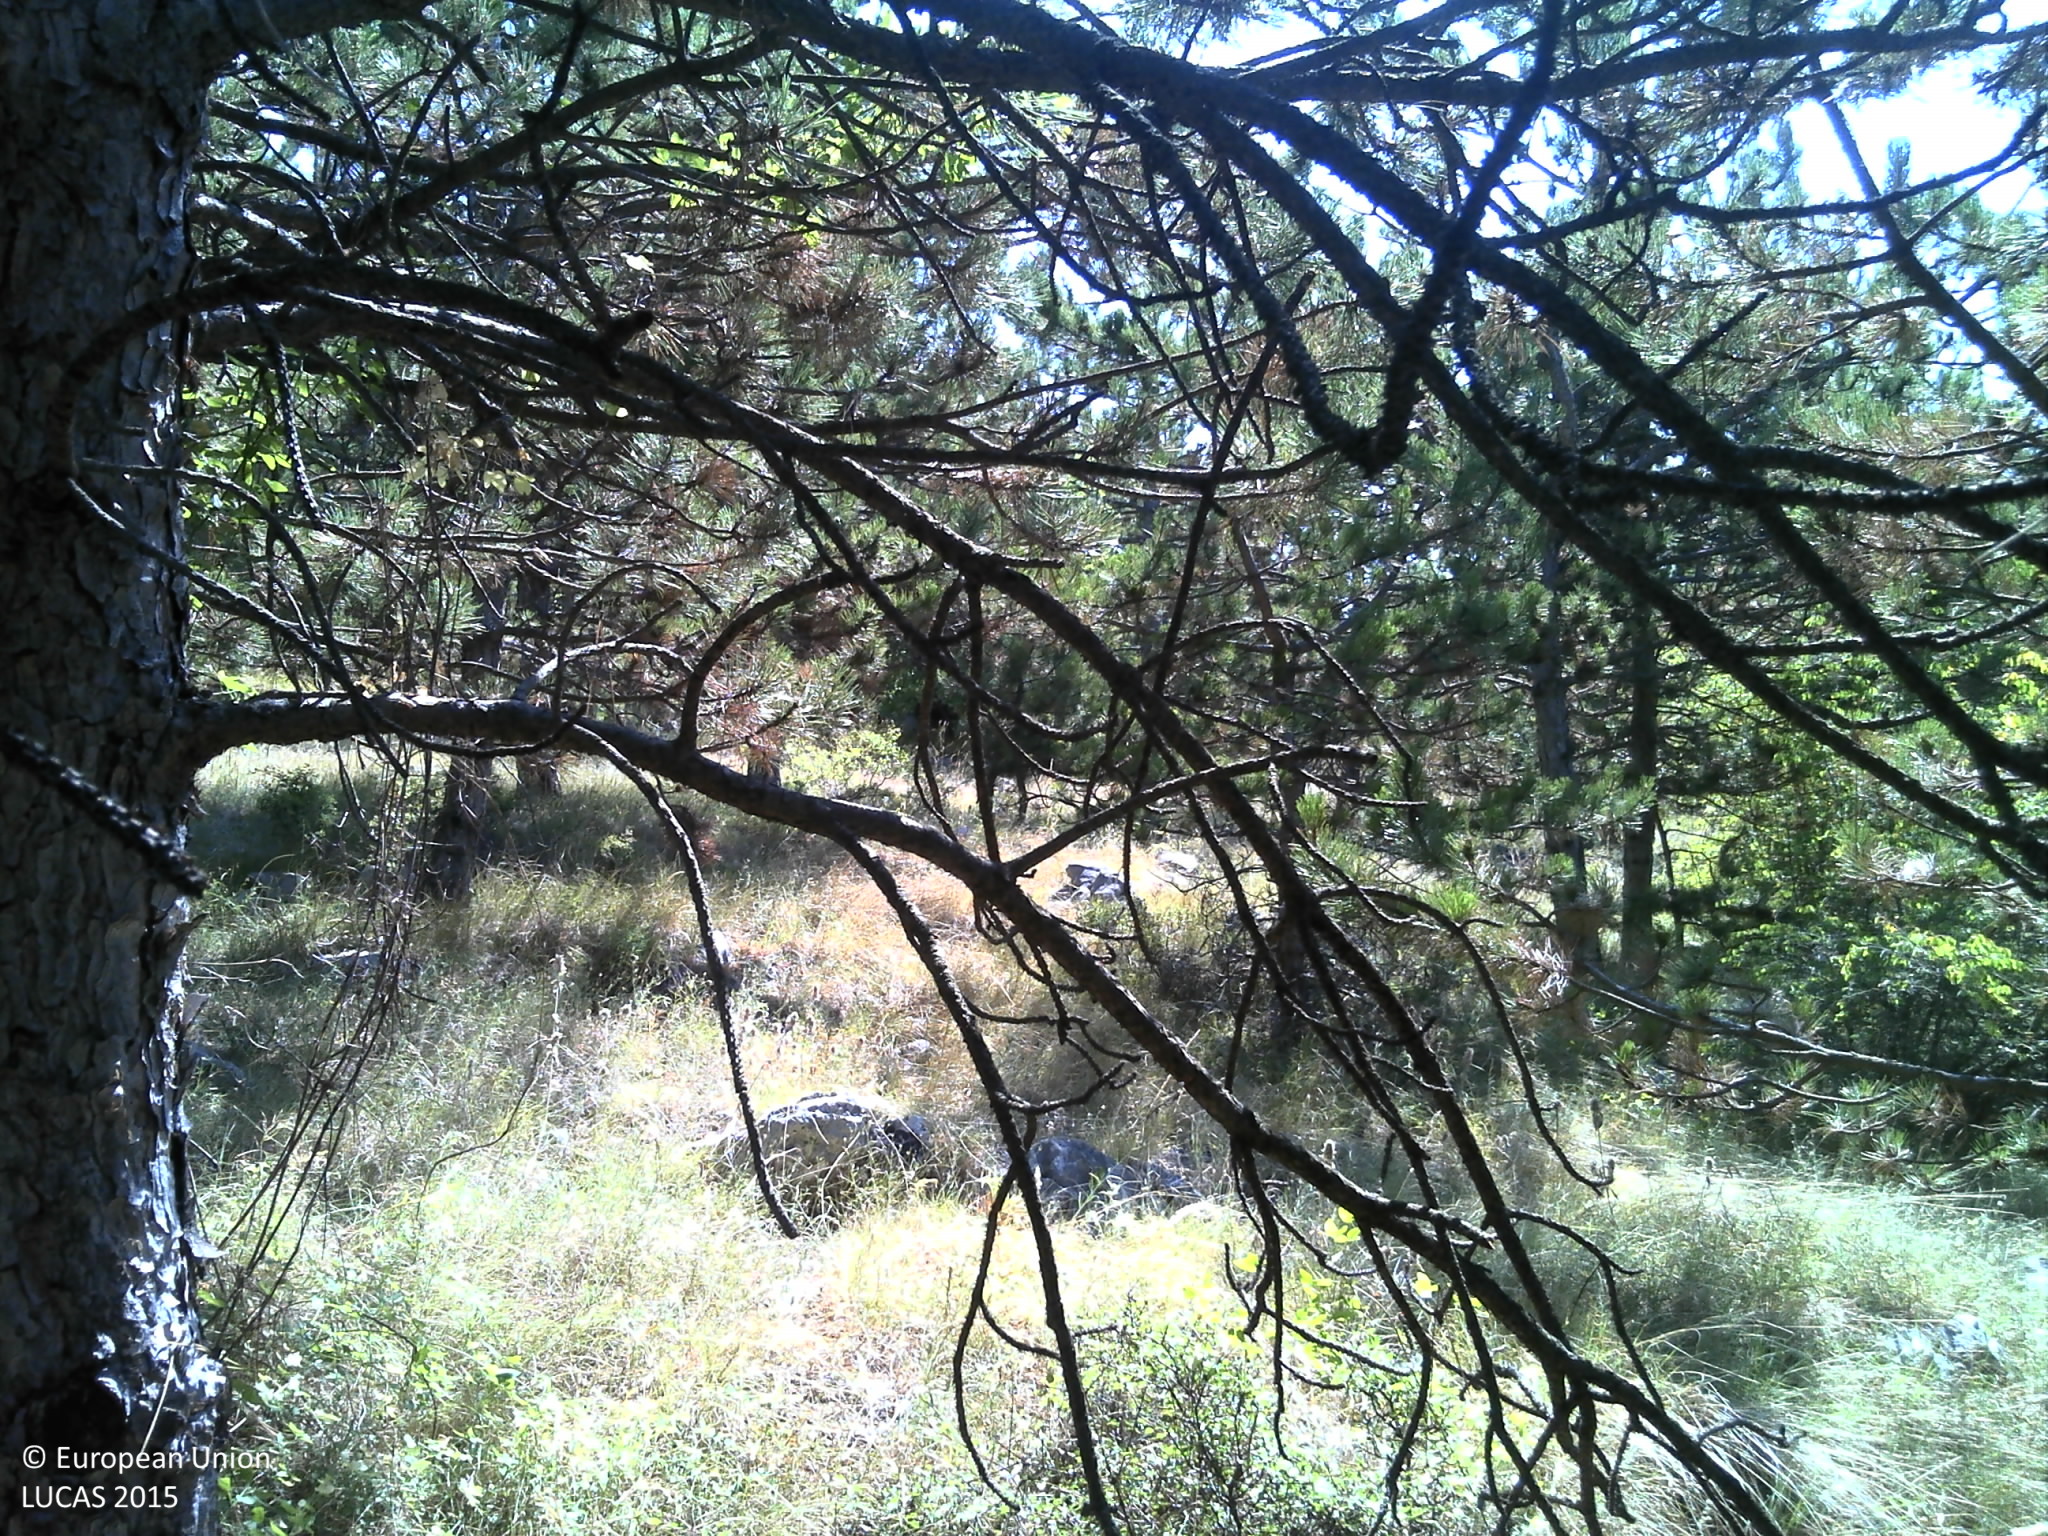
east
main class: Woodland
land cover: Pine dominated coniferous woodland
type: coniferous forest of the mediterranean region
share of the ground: > 75 %
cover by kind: coniferous forest trees 80 %, shrubs 10 %, herbaceous plants 5 %, consolidated bare surface 5 %
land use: Semi-natural and natural areas not in use
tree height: > 5 m
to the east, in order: Pine dominated coniferous woodland; Paved roads, cycling and walking lanes; Pine dominated coniferous woodland; Shrubland with sparse tree cover; Grassland with sparse tree/shrub cover; Tracks; Grassland with sparse tree/shrub cover; Broadleaved woodland; Shrubland with sparse tree cover
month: July
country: HR
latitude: 43.4684
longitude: 17.1737
